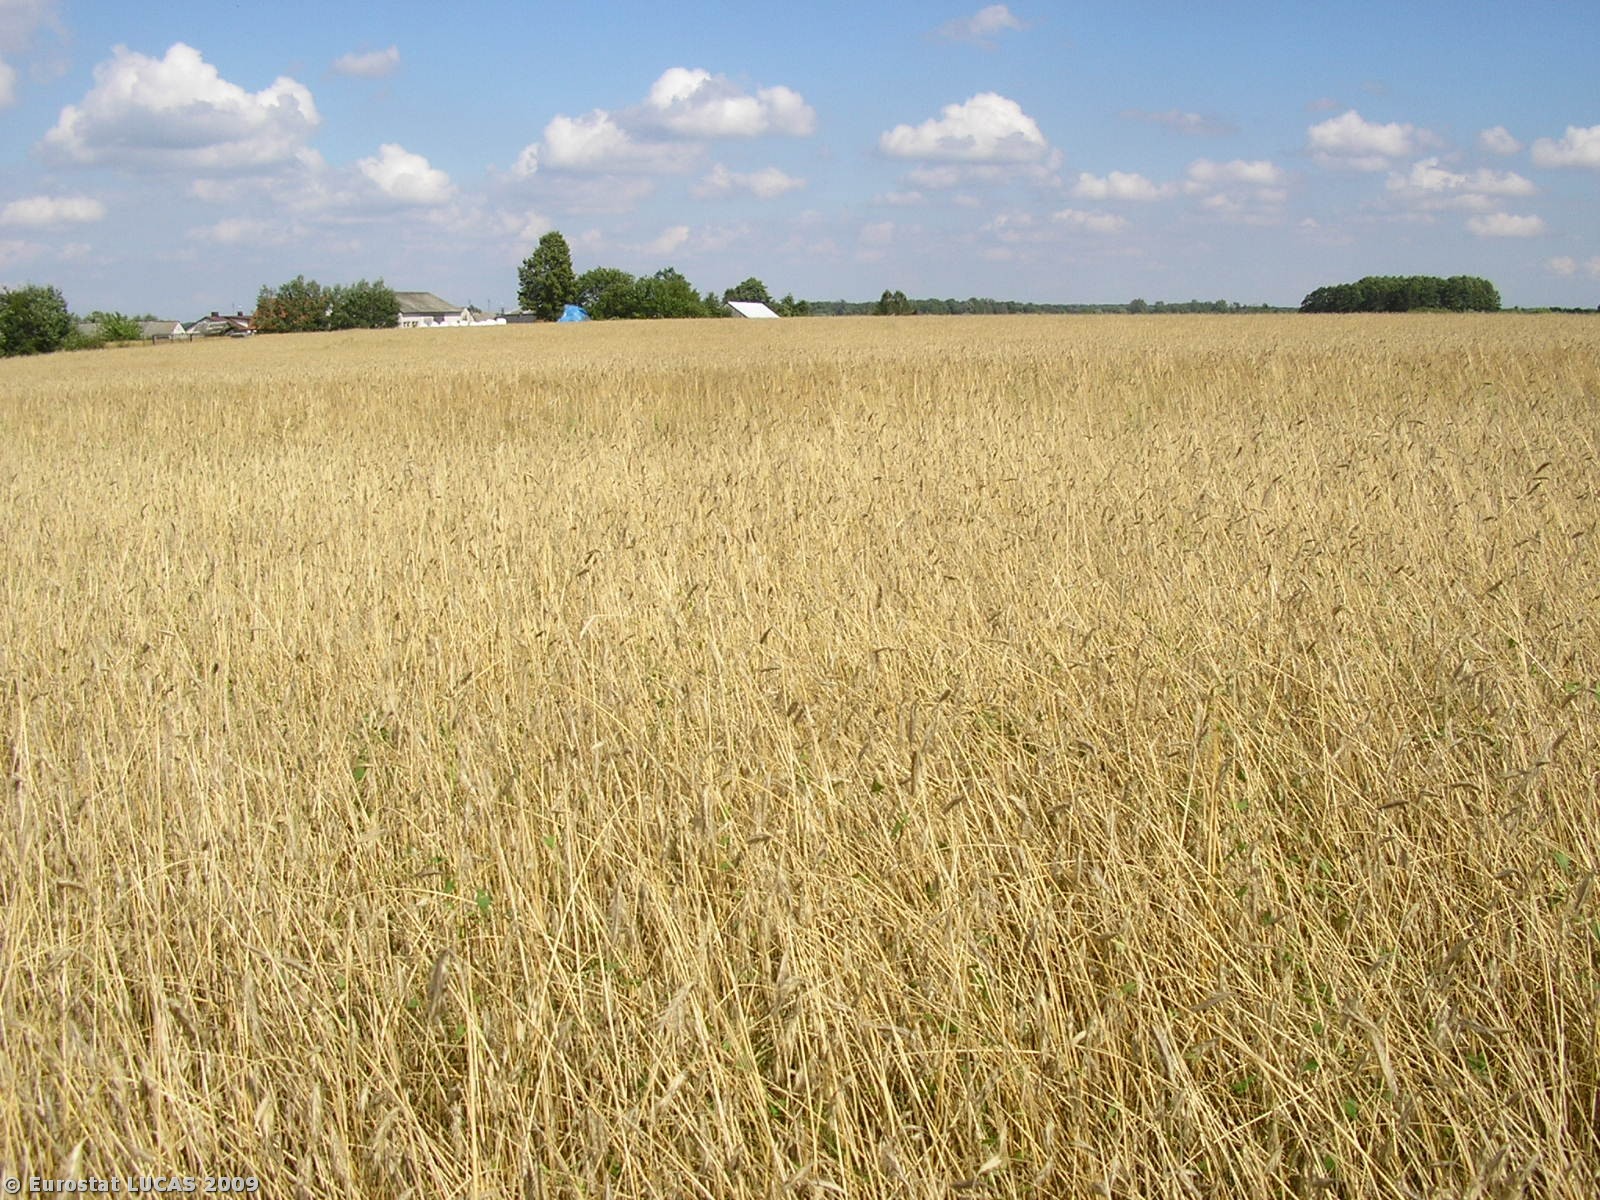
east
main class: Cropland
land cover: Rye
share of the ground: > 75 %
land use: Agriculture (excluding fallow land and kitchen gardens)
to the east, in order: Rye; Oats; Triticale; Rye
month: July
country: PL
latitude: 52.2304
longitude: 22.2586
